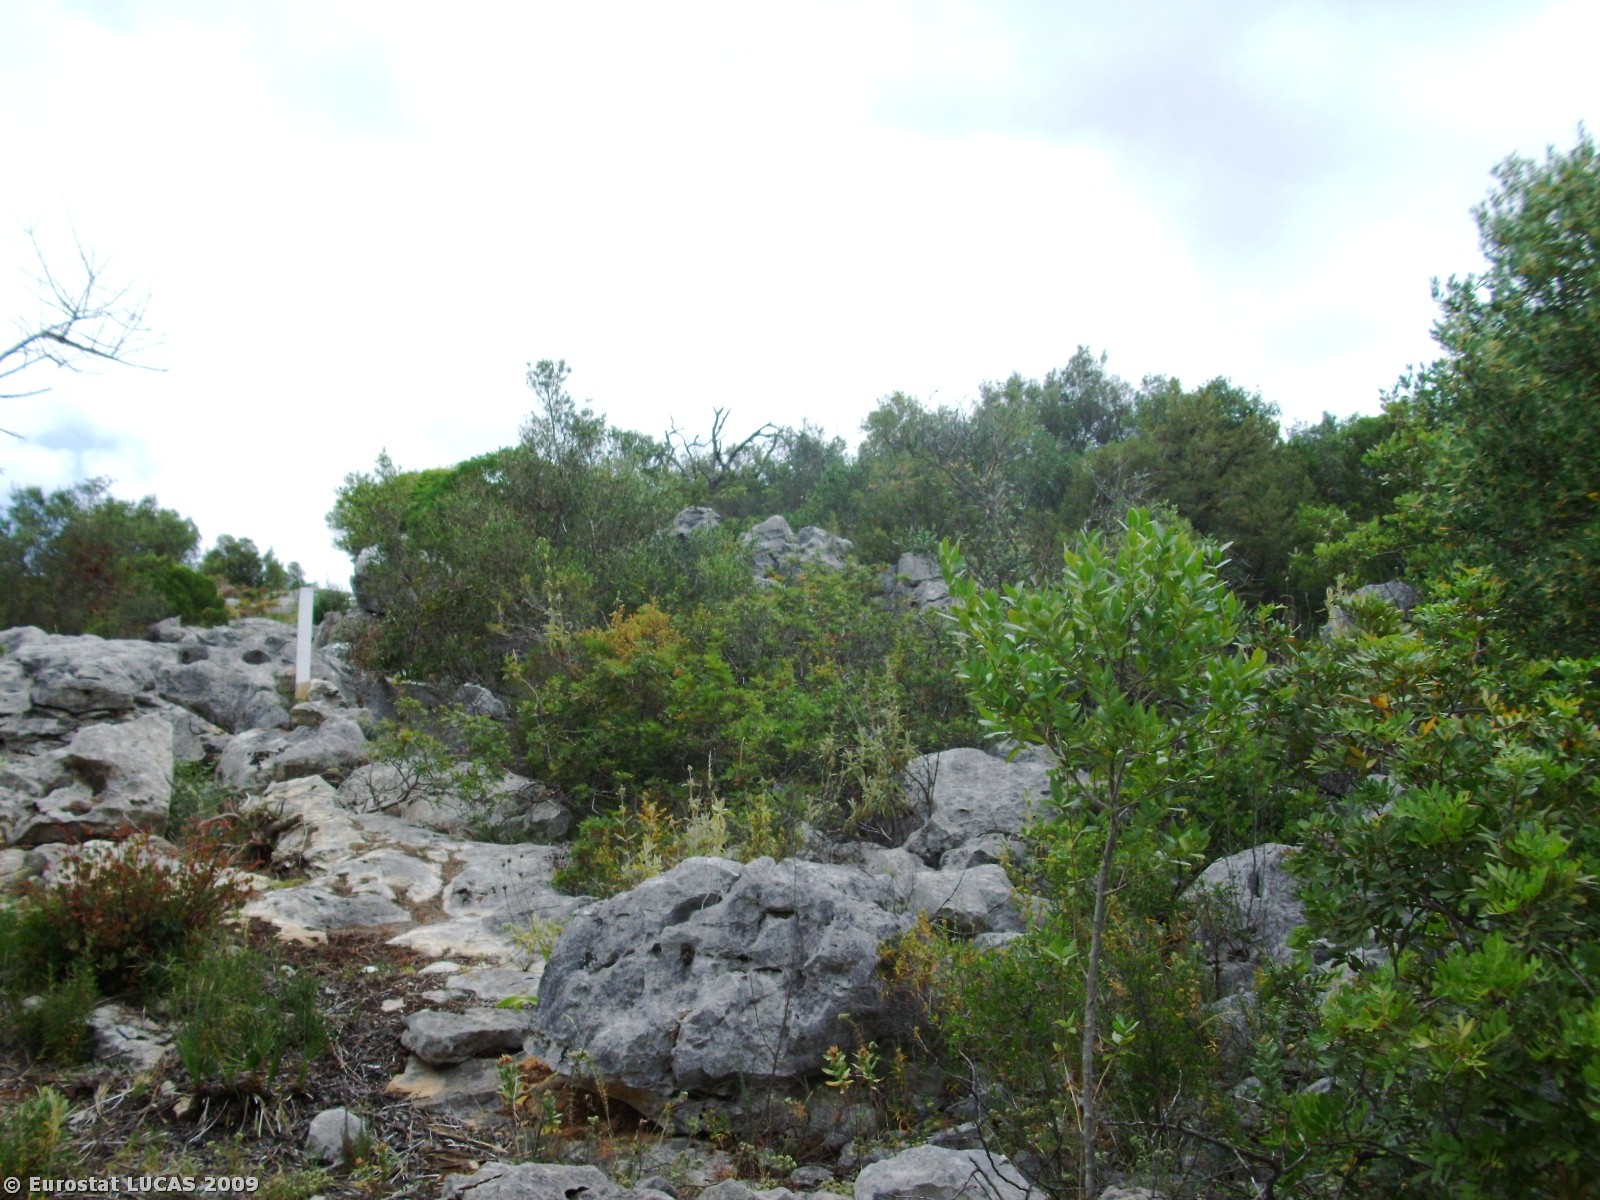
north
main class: Shrubland
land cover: Shrubland with sparse tree cover
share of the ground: 50 - 75 %
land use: Unused
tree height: > 5 m
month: May
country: PT
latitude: 37.1419
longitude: -8.1068
